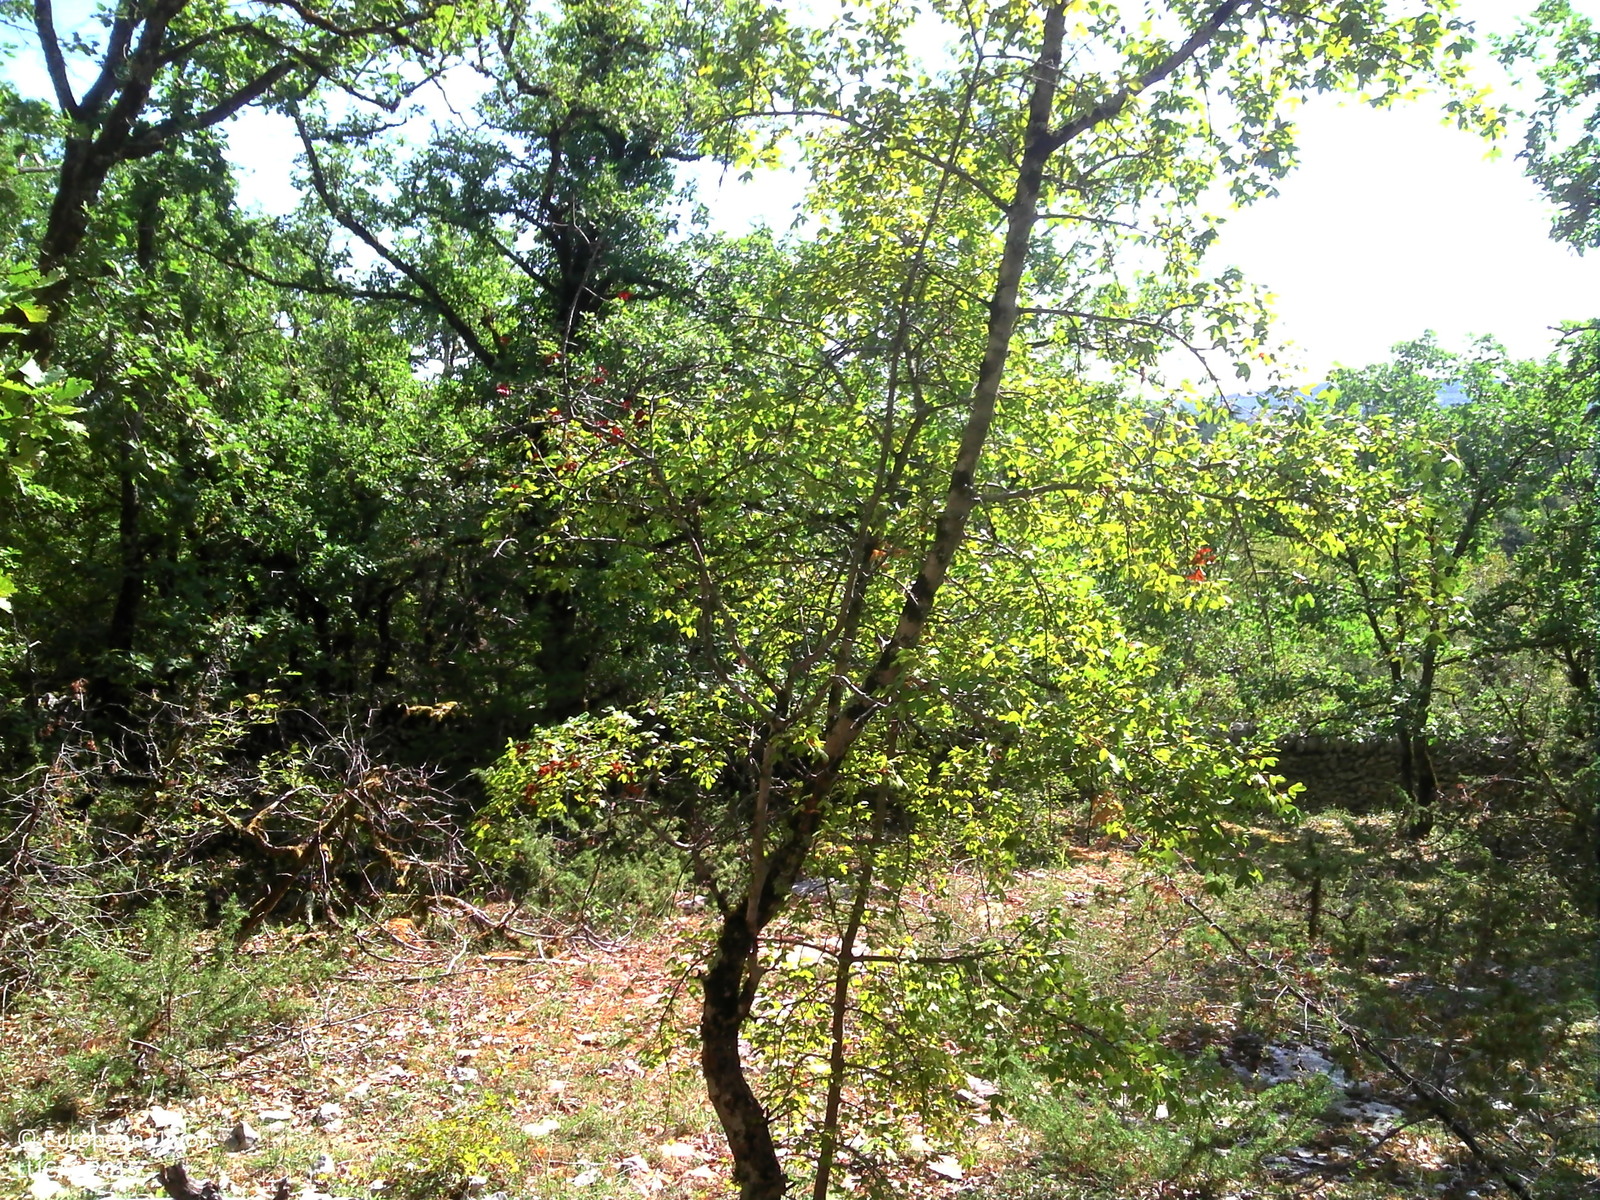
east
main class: Woodland
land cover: Broadleaved woodland
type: thermophilous deciduous forest
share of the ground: > 75 %
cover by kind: broadleaved forest trees 75 %, shrubs 10 %, unconsolidated bare surface 10 %, herbaceous plants 5 %
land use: Semi-natural and natural areas not in use
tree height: > 5 m
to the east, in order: Broadleaved woodland; Dry stone walls; Broadleaved woodland; Dry stone walls; Grassland with sparse tree/shrub cover; Dry stone walls; Broadleaved woodland; Fences; Dry stone walls; Electric lines; Grass margins; Paved roads, cycling and walking lanes; Grass margins; Broadleaved woodland; Fences; Broadleaved woodland; Dry stone walls; Broadleaved woodland; Grass margins; Paved roads, cycling and walking lanes; Grass margins; Electric lines; Grass margins; Broadleaved woodland; Spontaneously vegetated surfaces
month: September
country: FR
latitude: 44.5892
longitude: 1.8244
